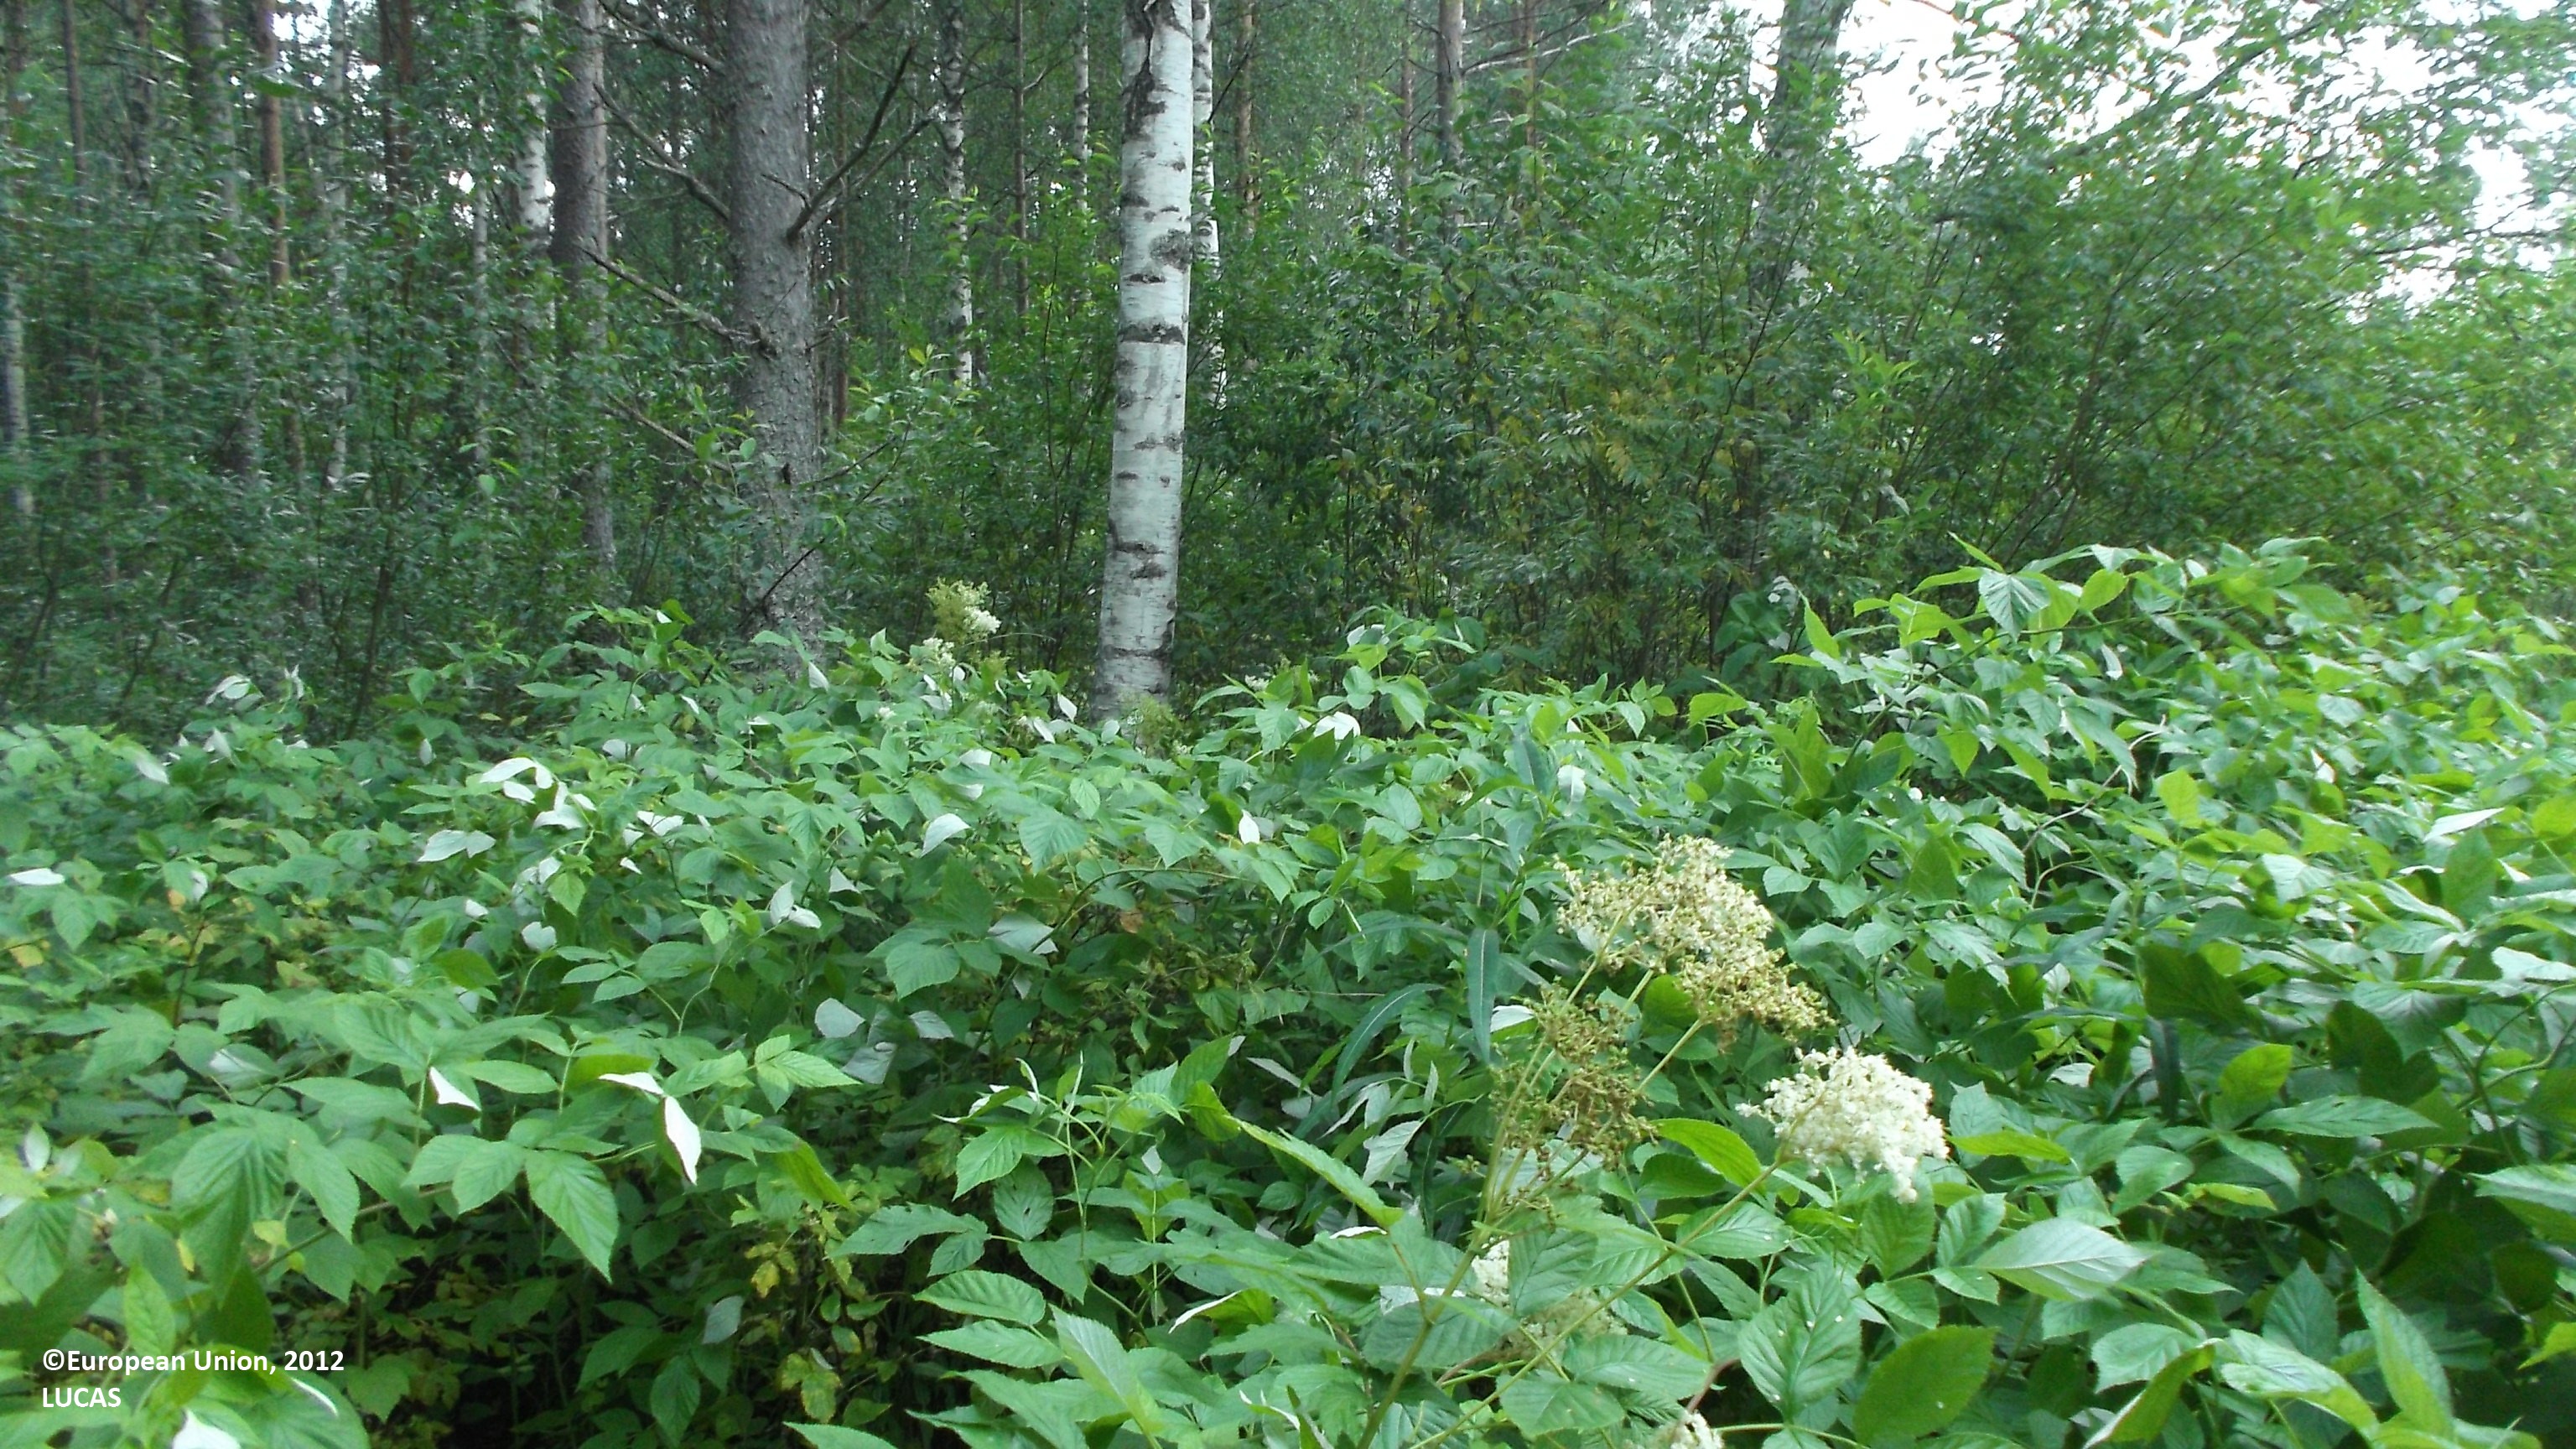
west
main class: Shrubland
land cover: Shrubland with sparse tree cover
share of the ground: 25 - 50 %
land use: Forestry
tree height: > 5 m
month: August
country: FI
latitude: 63.0745
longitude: 24.3932
